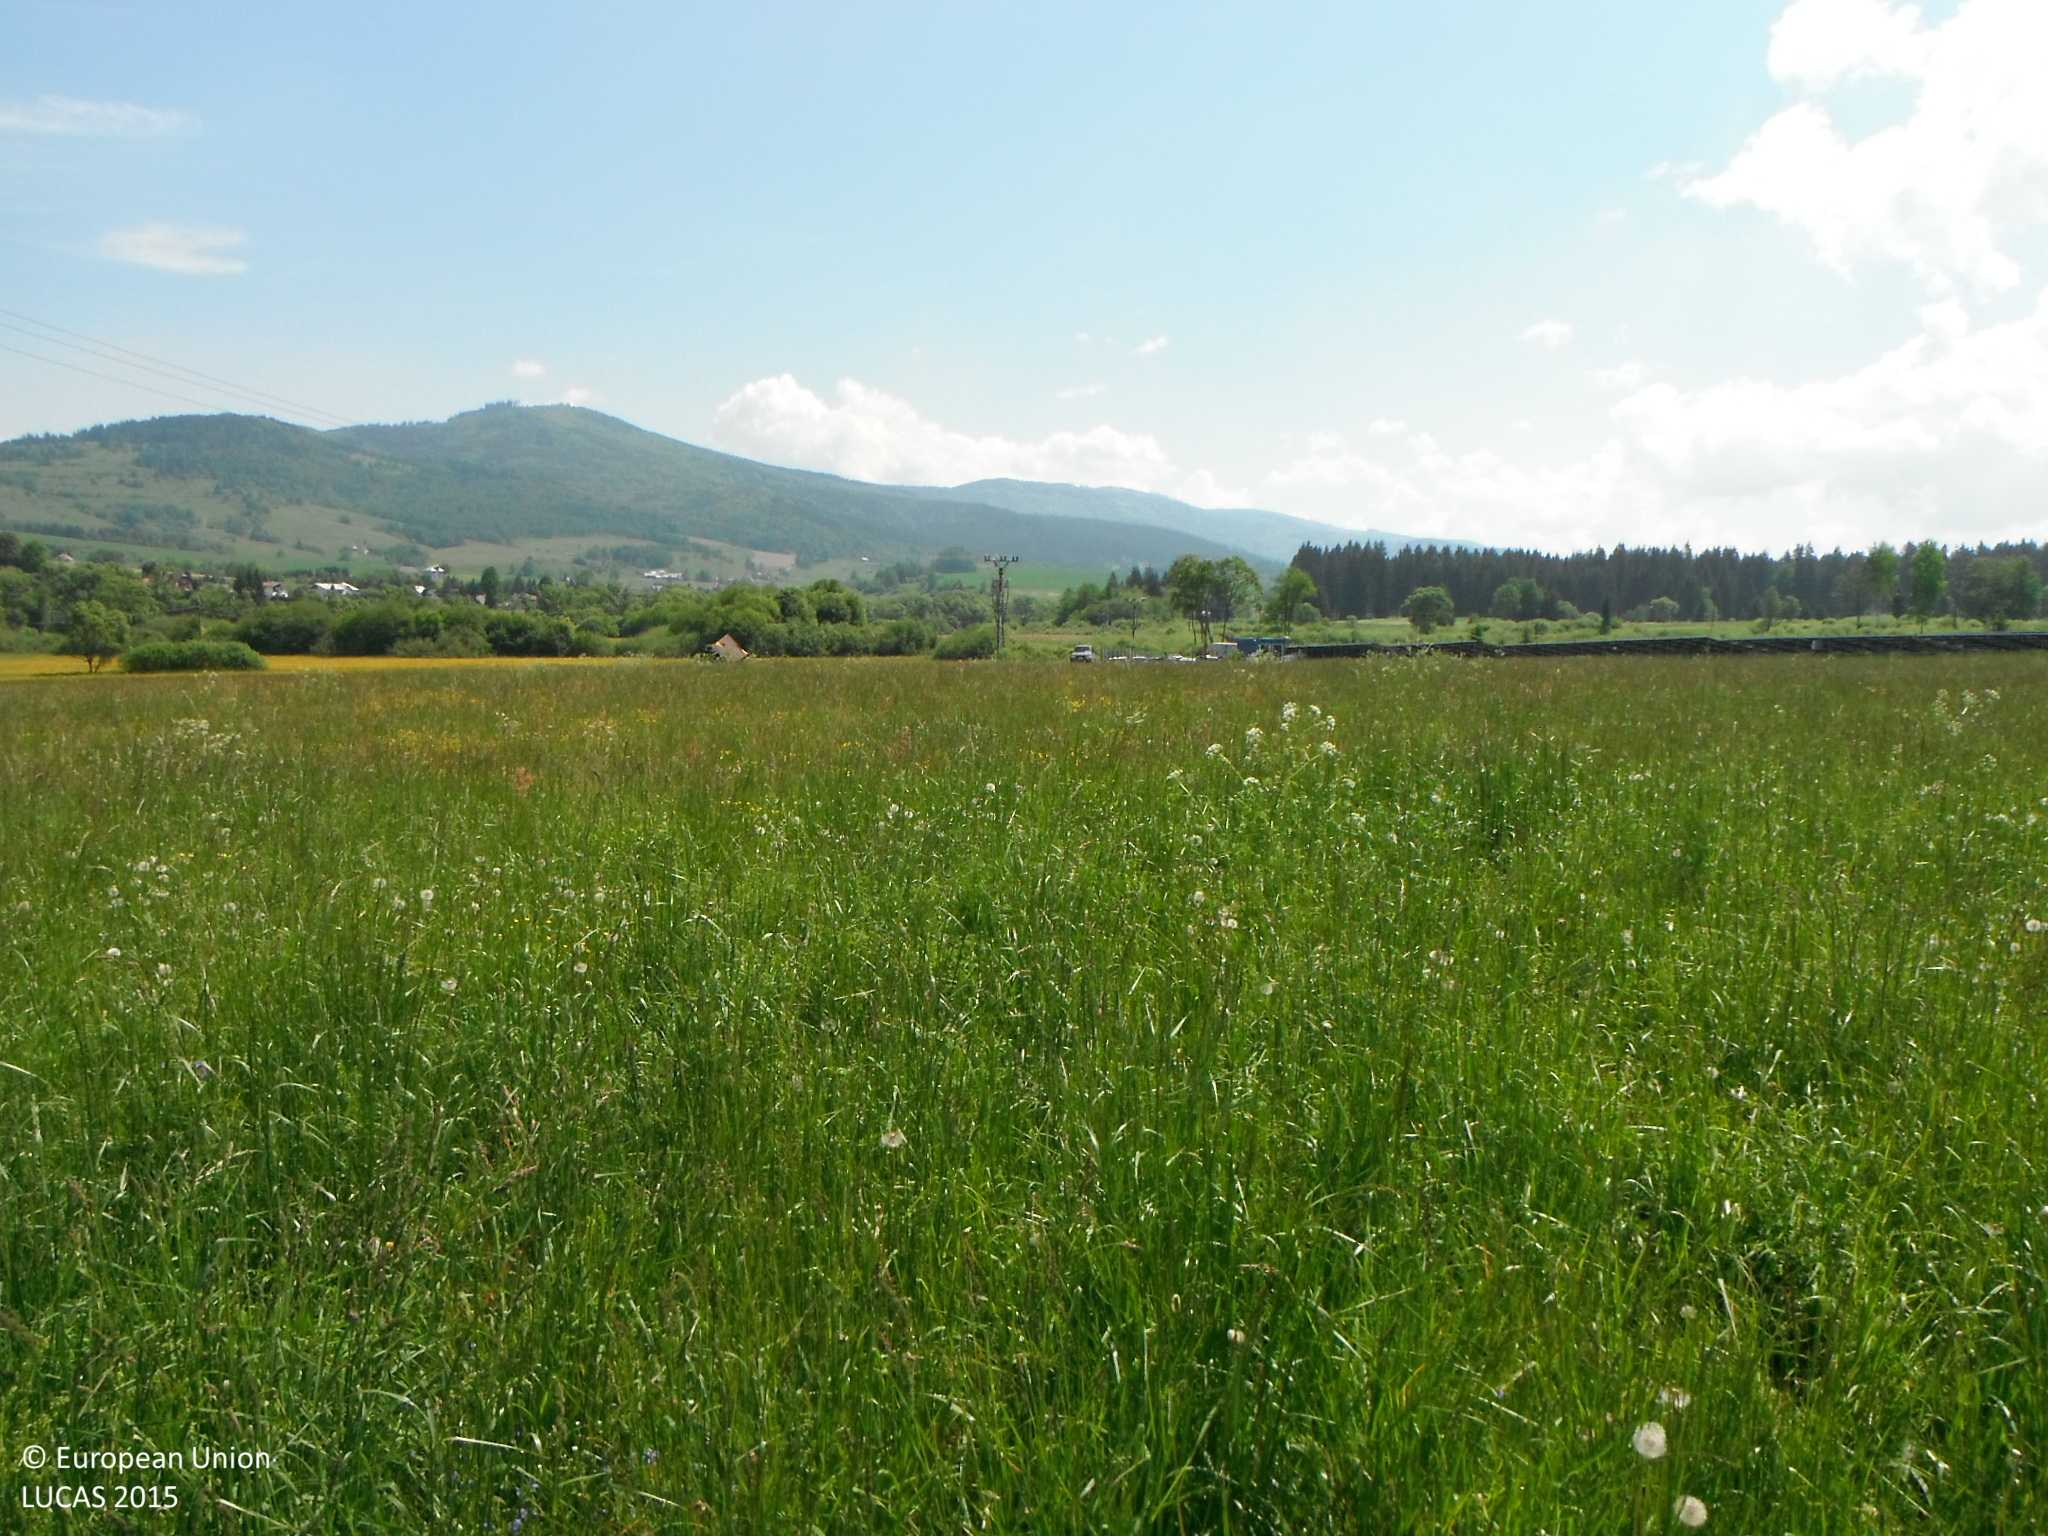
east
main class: Grassland
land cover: Grassland without tree/shrub cover
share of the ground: > 75 %
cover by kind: herbaceous plants 100 %
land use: Agriculture (excluding fallow land and kitchen gardens)
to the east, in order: Grassland without tree/shrub cover; Paved roads, cycling and walking lanes; Grassland without tree/shrub cover; Electric lines; Grassland without tree/shrub cover; Shrubland without tree cover; Ditches and canals; Grass margins
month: June
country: SK
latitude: 48.7910
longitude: 19.7054
